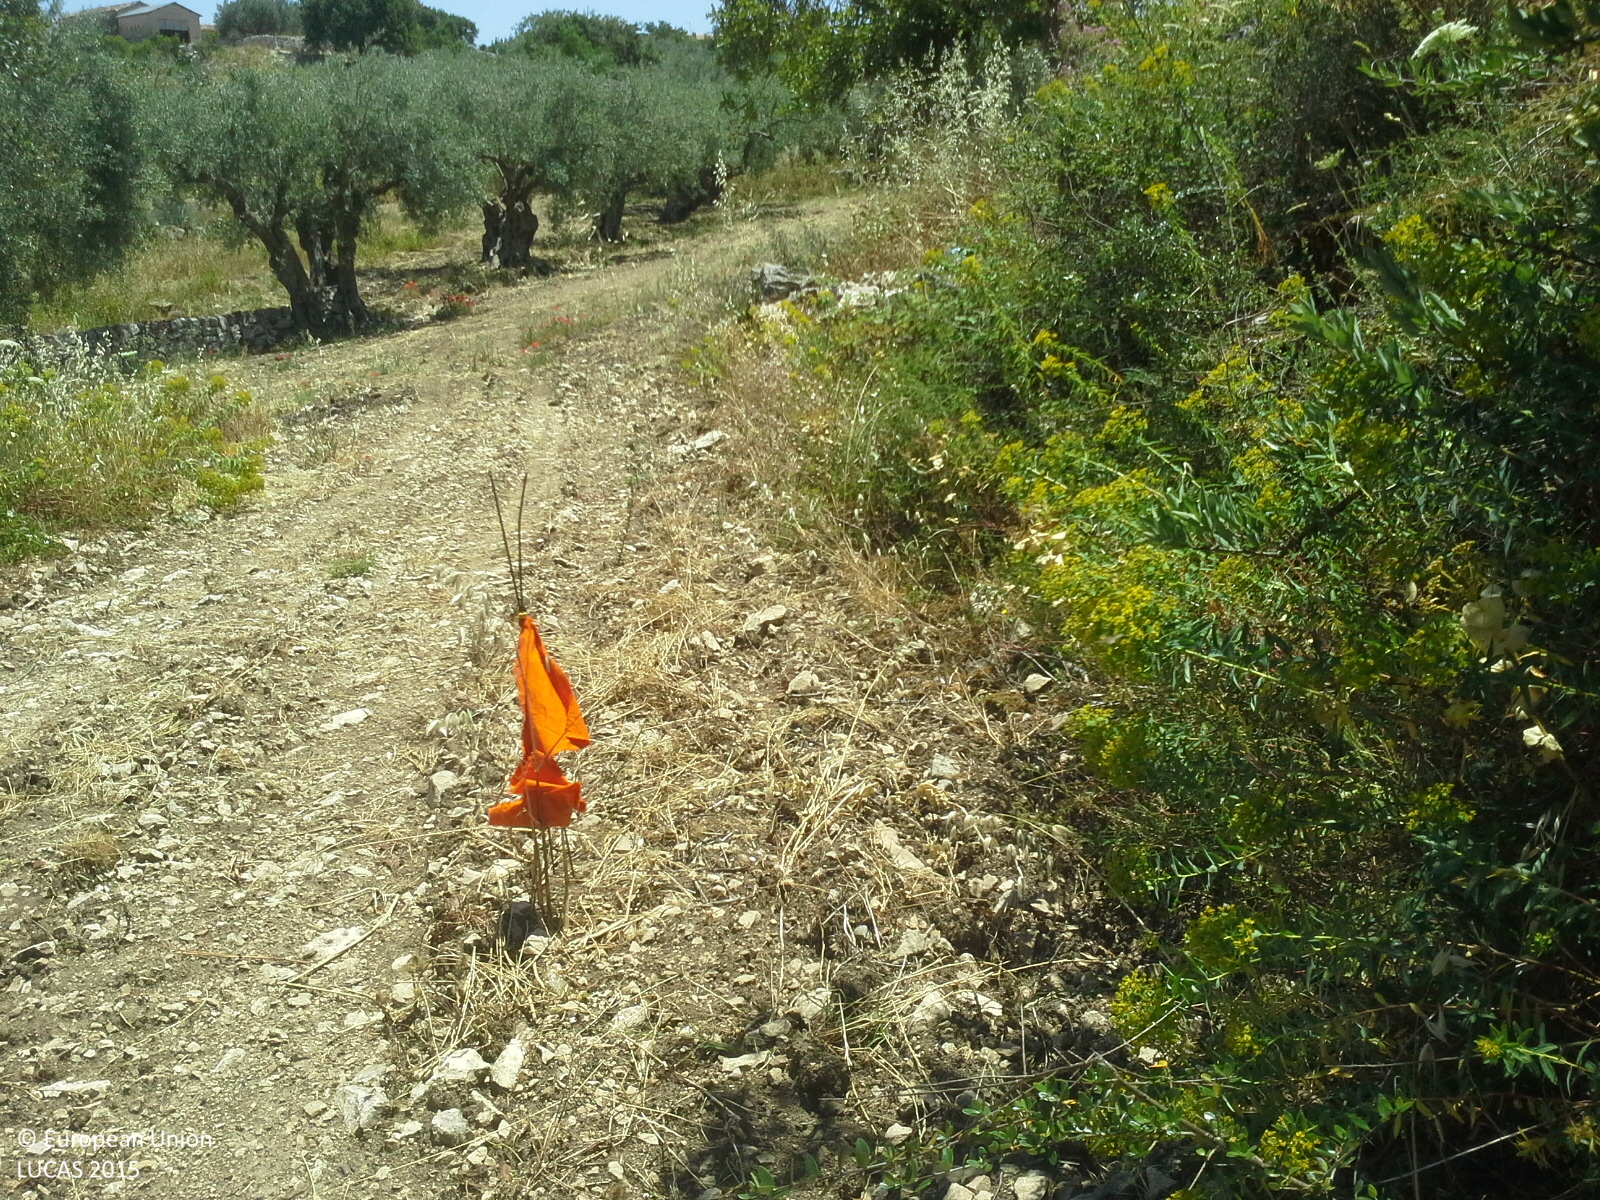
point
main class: Grassland
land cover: Grassland with sparse tree/shrub cover
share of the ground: > 75 %
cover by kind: herbaceous plants 95 %, coniferous forest trees 5 %
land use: Agriculture (excluding fallow land and kitchen gardens)
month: June
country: IT
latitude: 36.9147
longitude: 14.8443
